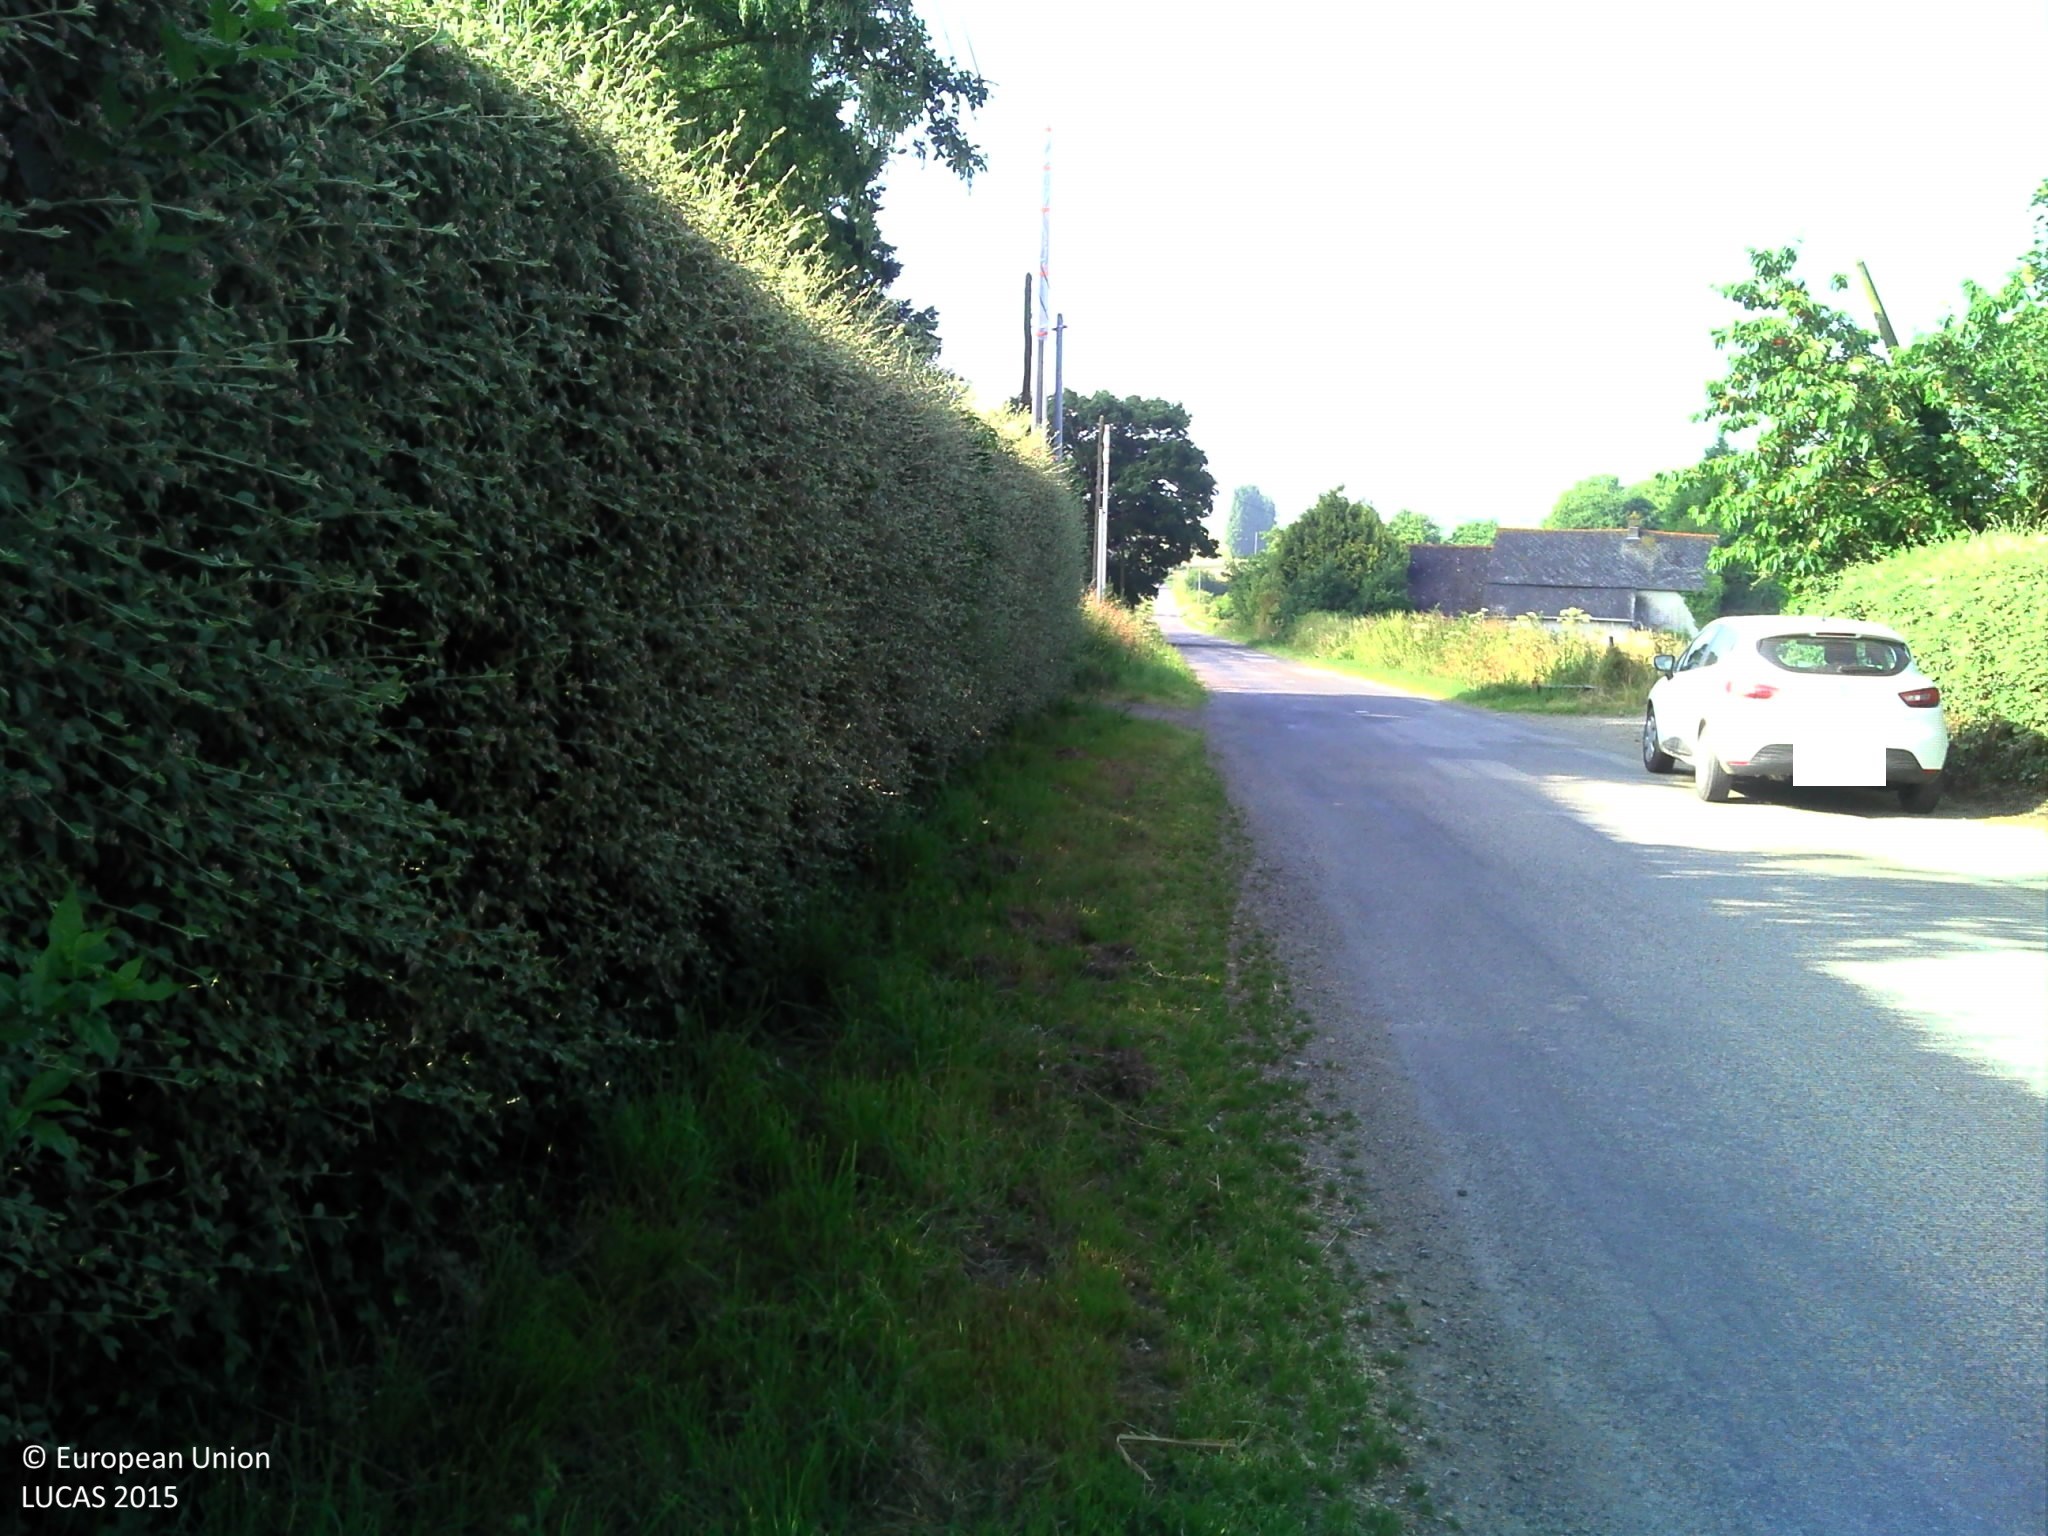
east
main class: Grassland
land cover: Grassland with sparse tree/shrub cover
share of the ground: > 75 %
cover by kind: herbaceous plants 95 %, broadleaved forest trees 5 %
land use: Residential
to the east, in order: Grassland with sparse tree/shrub cover; Artificial constructions in urban areas; Broadleaved woodland; Fences; Maize; Electric lines; Maize; Grass margins; Ditches and canals; Paved roads, cycling and walking lanes; Grass margins; Managed hedges; Artificial constructions in urban areas; Managed hedges; Maize
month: June
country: FR
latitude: 48.0268
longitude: -1.4290
